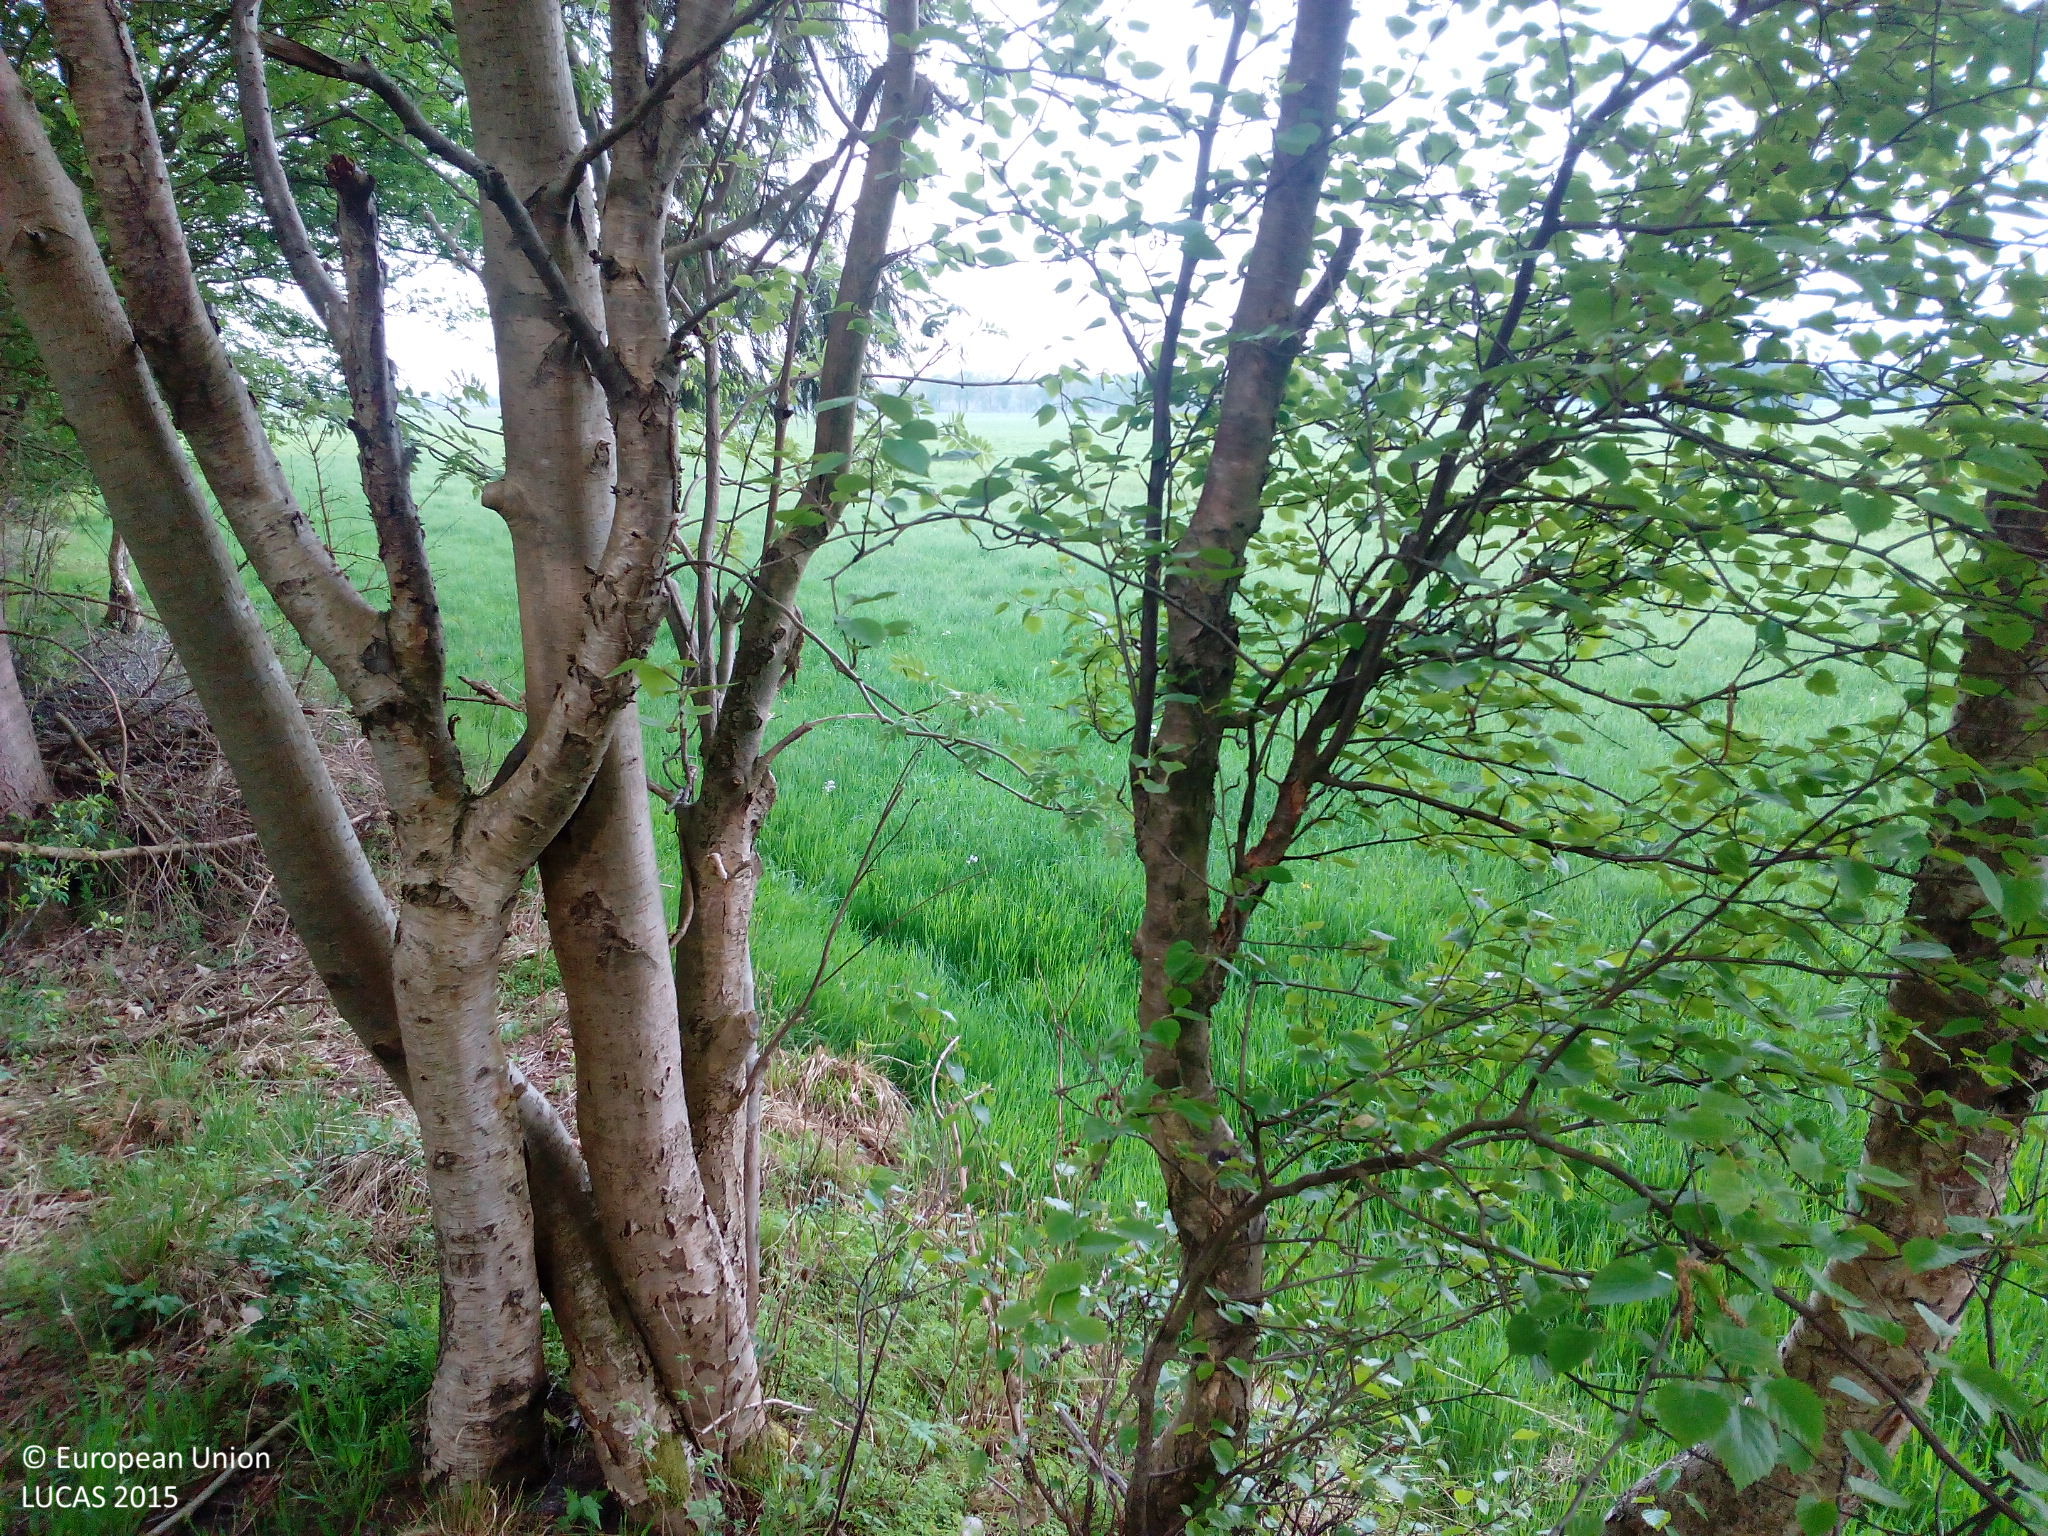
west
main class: Woodland
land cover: Broadleaved woodland
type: mire and swamp forests
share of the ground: > 75 %
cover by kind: broadleaved forest trees 70 %, coniferous forest trees 10 %, shrubs 10 %, herbaceous plants 10 %
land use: Semi-natural and natural areas not in use
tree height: > 5 m
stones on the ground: < 10 %
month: May
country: DE
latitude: 53.2376
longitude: 9.2063
